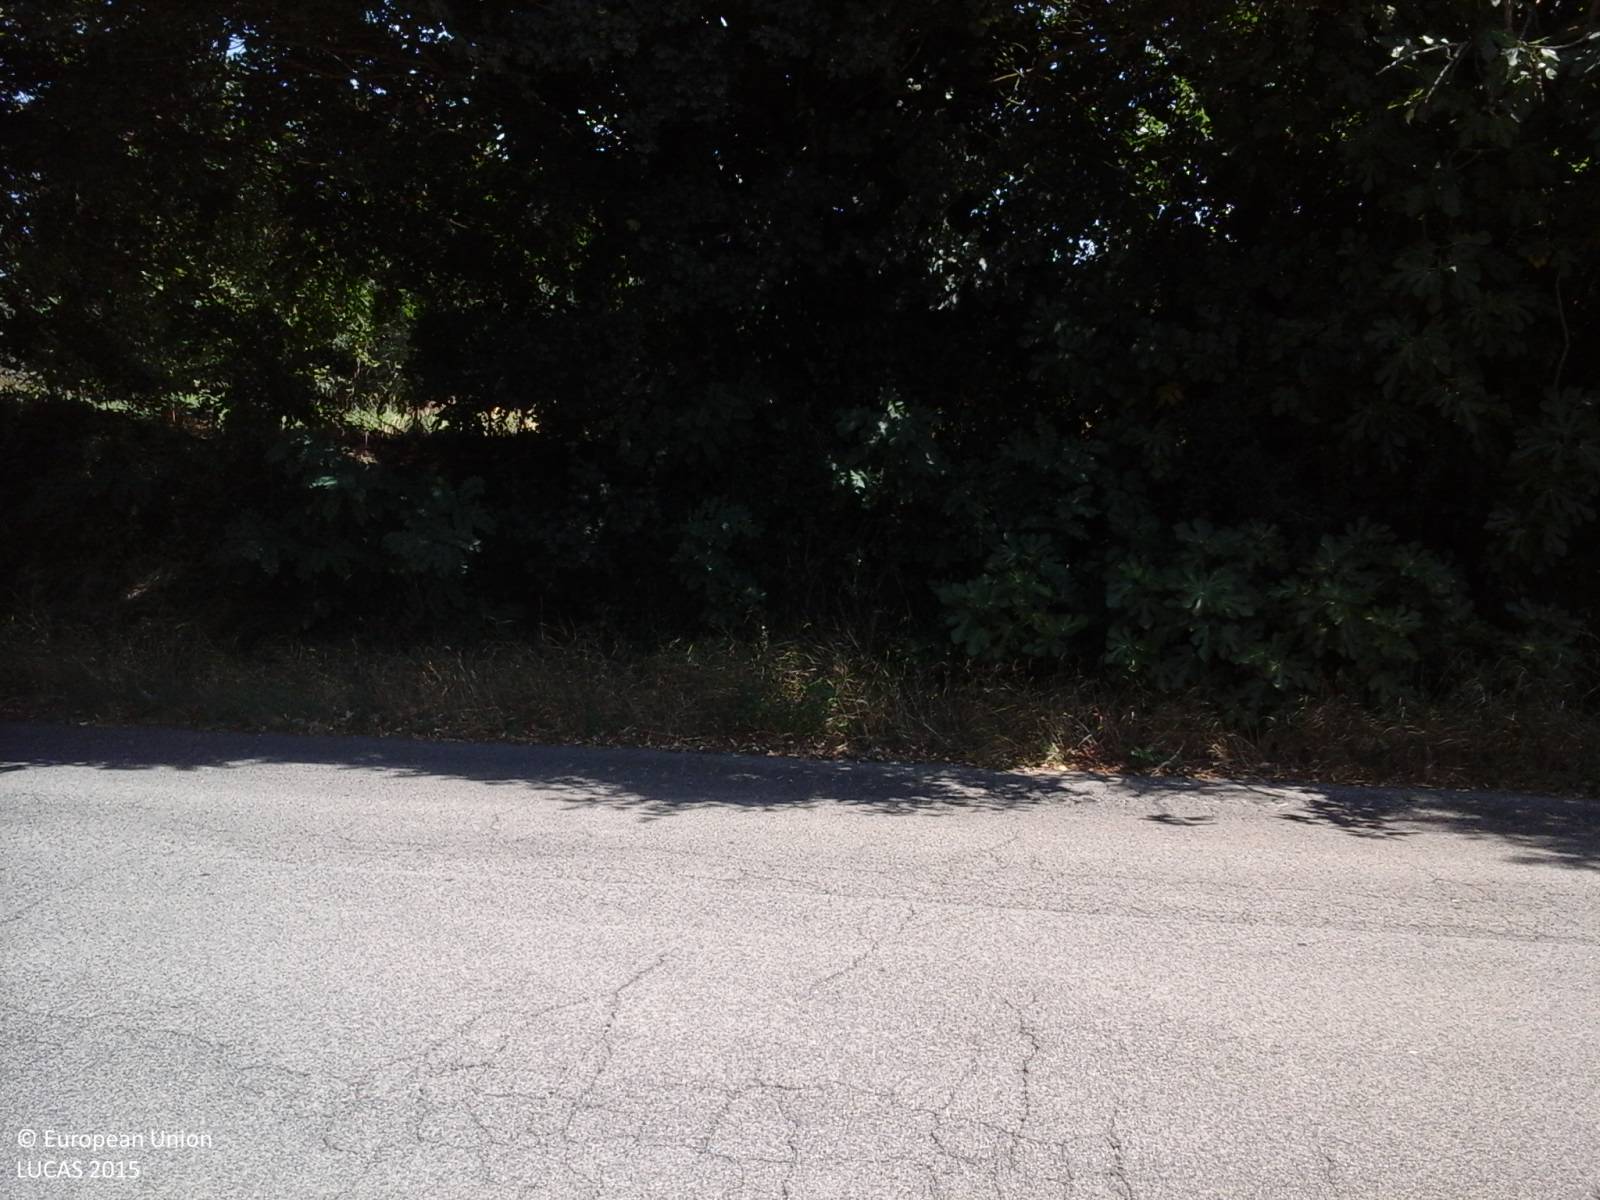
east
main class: Cropland
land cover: Olive groves
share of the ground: > 75 %
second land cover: Spontaneously vegetated surfaces
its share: > 75 %
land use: Kitchen garden
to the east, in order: Olive groves; Spontaneously vegetated surfaces; Fences; Electric lines; Paved roads, cycling and walking lanes; Grass margins; Ditches and canals; Abandoned hedges; Olive groves; Shrubland with sparse tree cover; Artificial constructions in urban areas; Olive groves; Paved roads, cycling and walking lanes; Single bushes/trees; Paved roads, cycling and walking lanes; Olive groves
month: July
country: IT
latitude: 42.2250
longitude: 12.5234
